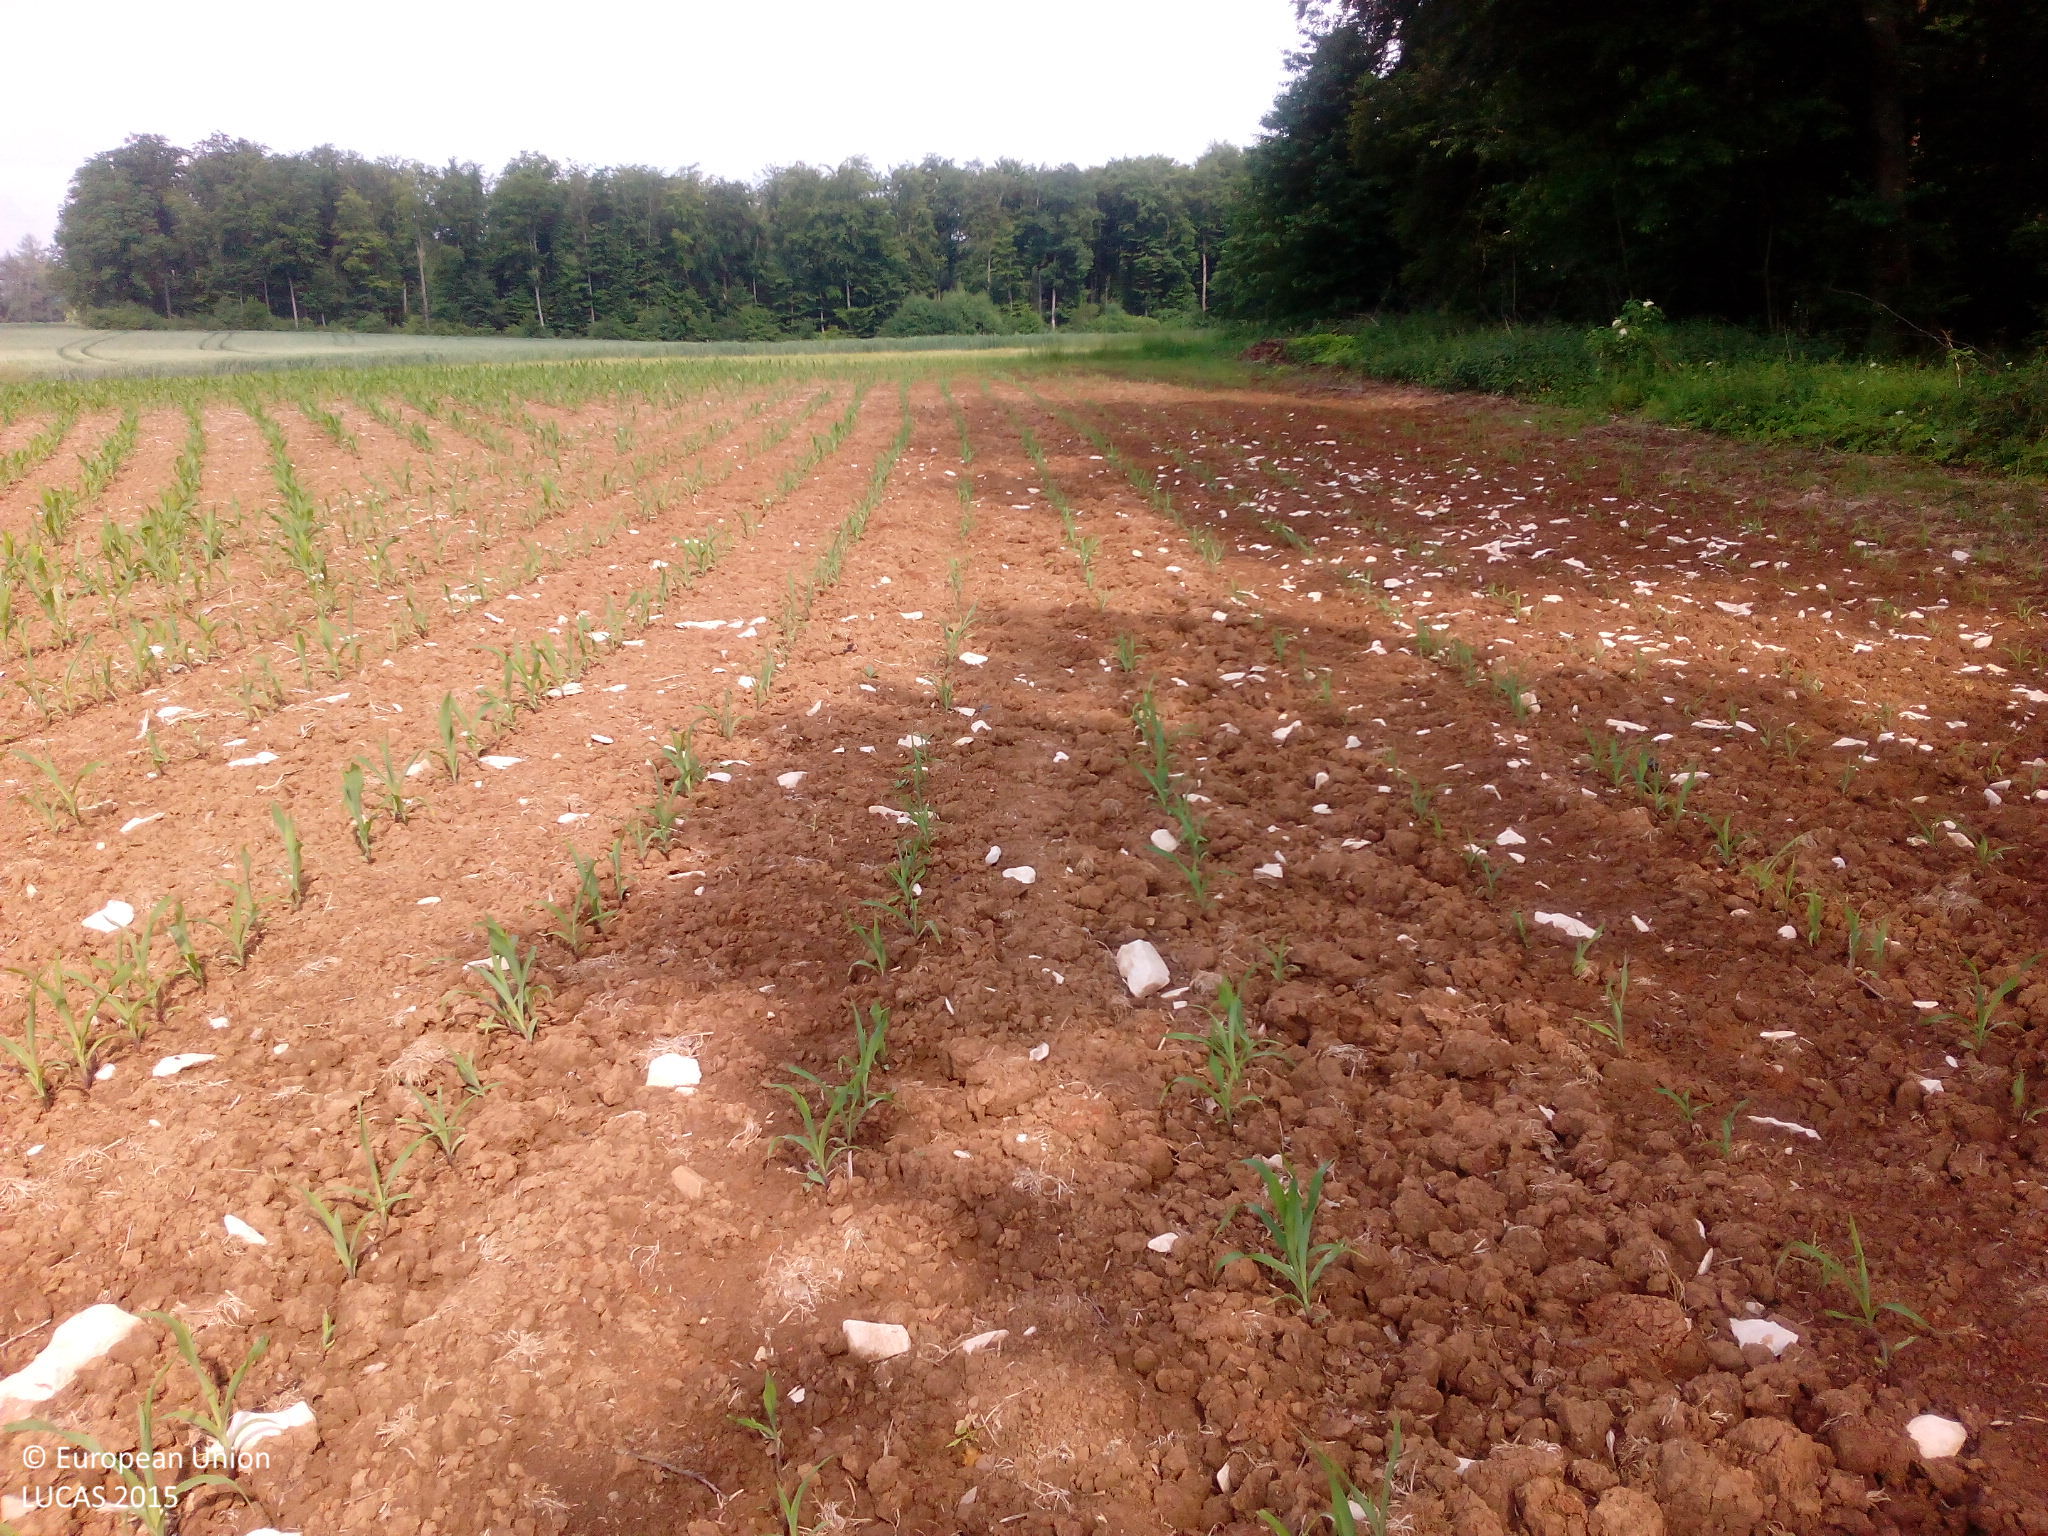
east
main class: Cropland
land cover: Maize
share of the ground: < 10 %
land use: Agriculture (excluding fallow land and kitchen gardens)
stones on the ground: < 10 %
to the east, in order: Maize; Grassland without tree/shrub cover; Common wheat; Broadleaved woodland
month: June
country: DE
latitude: 48.9577
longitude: 10.8873
